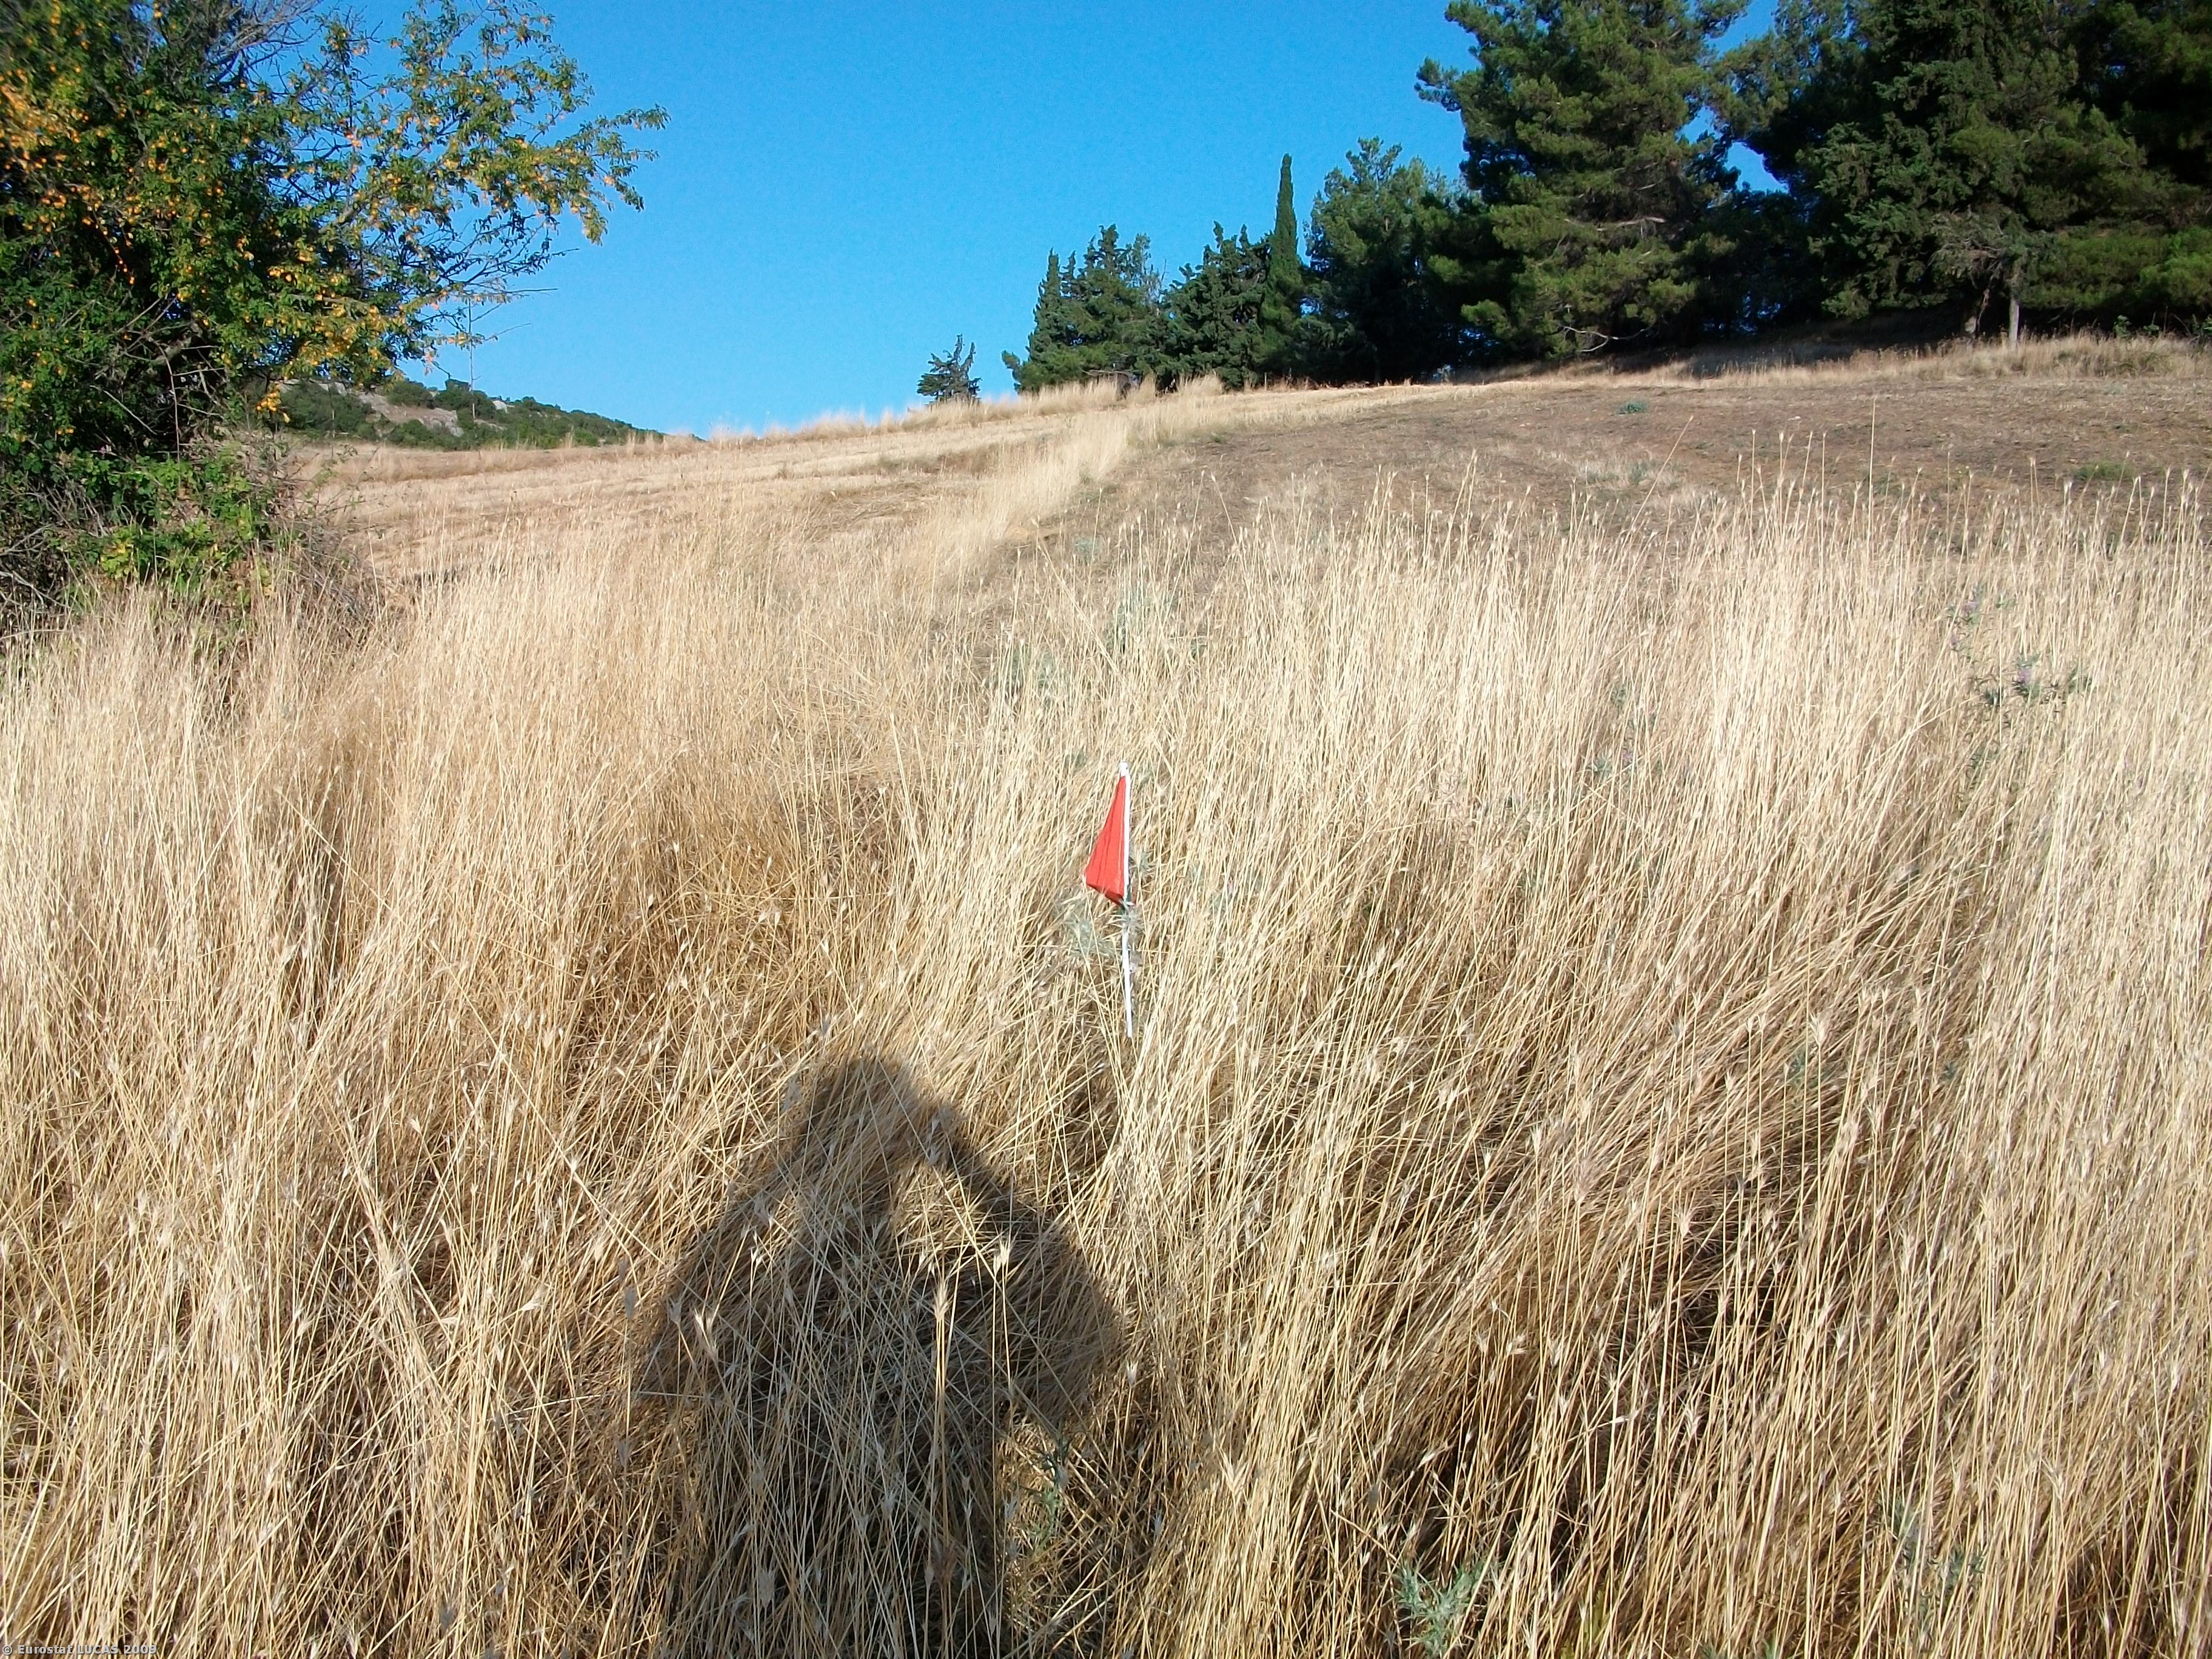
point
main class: Grassland
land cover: Grassland without tree/shrub cover
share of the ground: > 75 %
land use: Fallow land
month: July
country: GR
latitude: 39.1243
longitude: 22.3012
